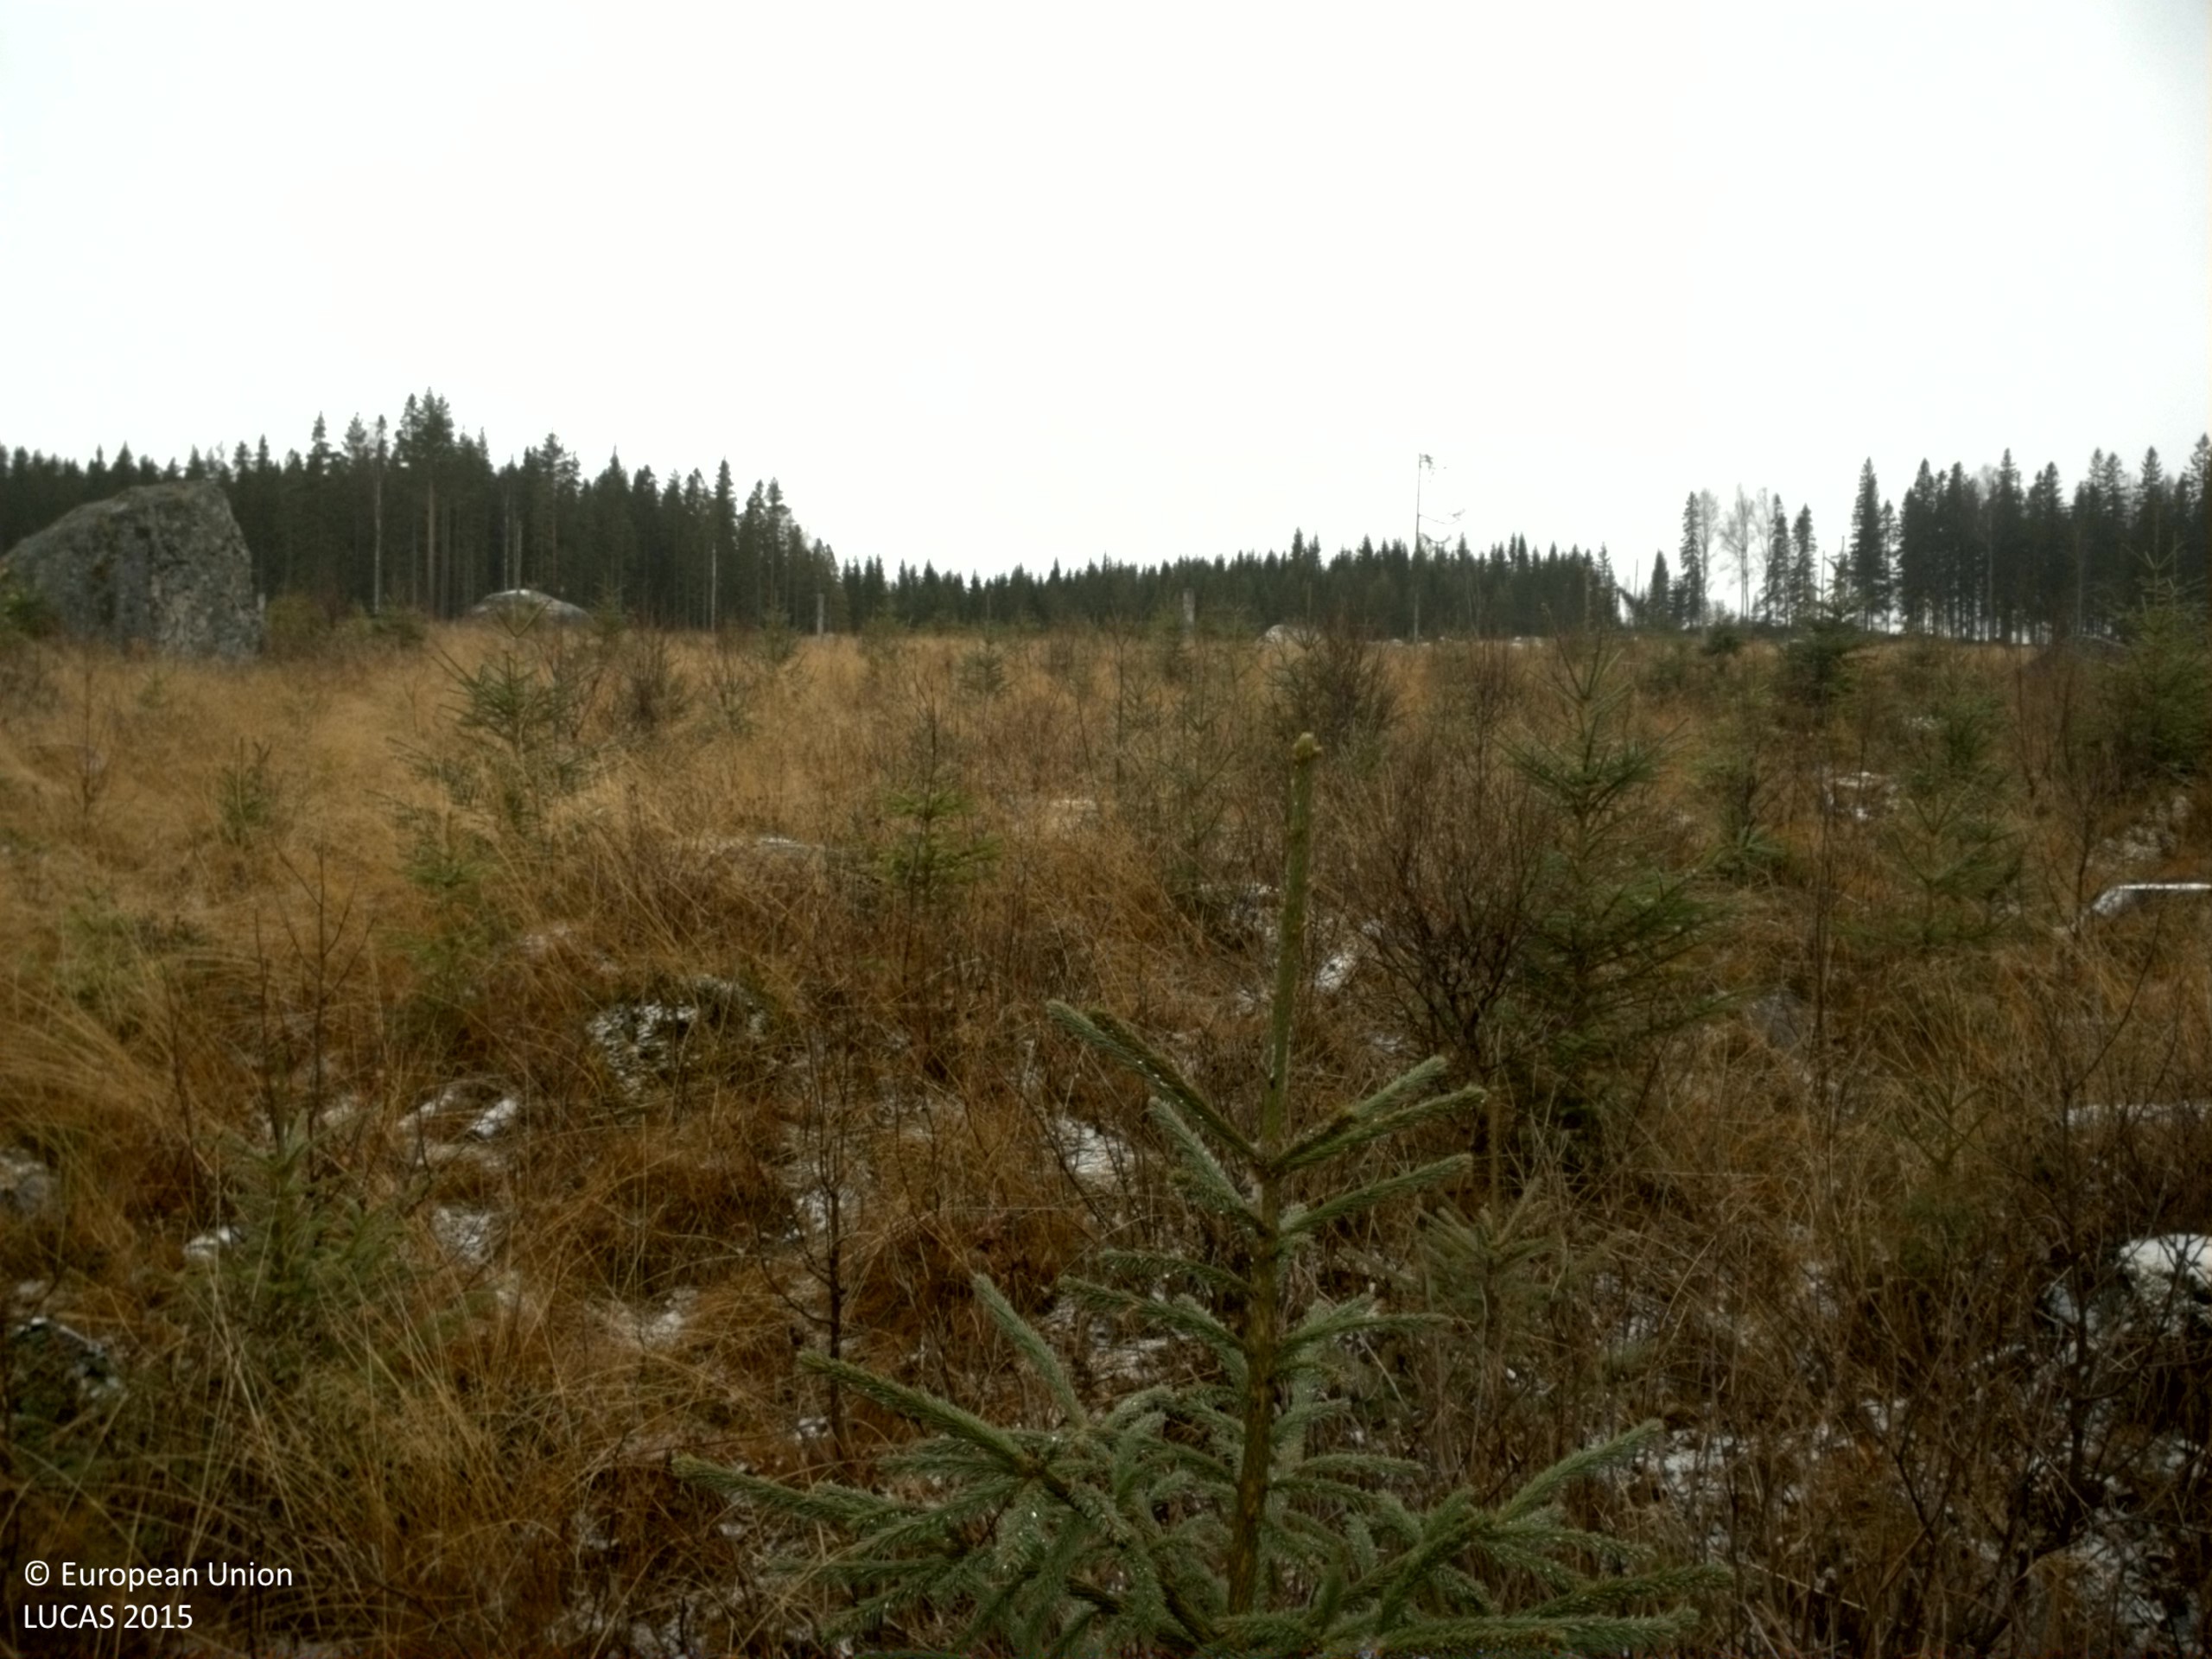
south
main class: Woodland
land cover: Spruce dominated mixed woodland
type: boreal forest
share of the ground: 25 - 50 %
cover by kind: herbaceous plants 45 %, consolidated bare surface 20 %, coniferous forest trees 15 %, broadleaved forest trees 15 %, shrubs 5 %
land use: Forestry
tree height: < 5 m
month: November
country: SE
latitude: 61.2421
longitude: 16.0779
